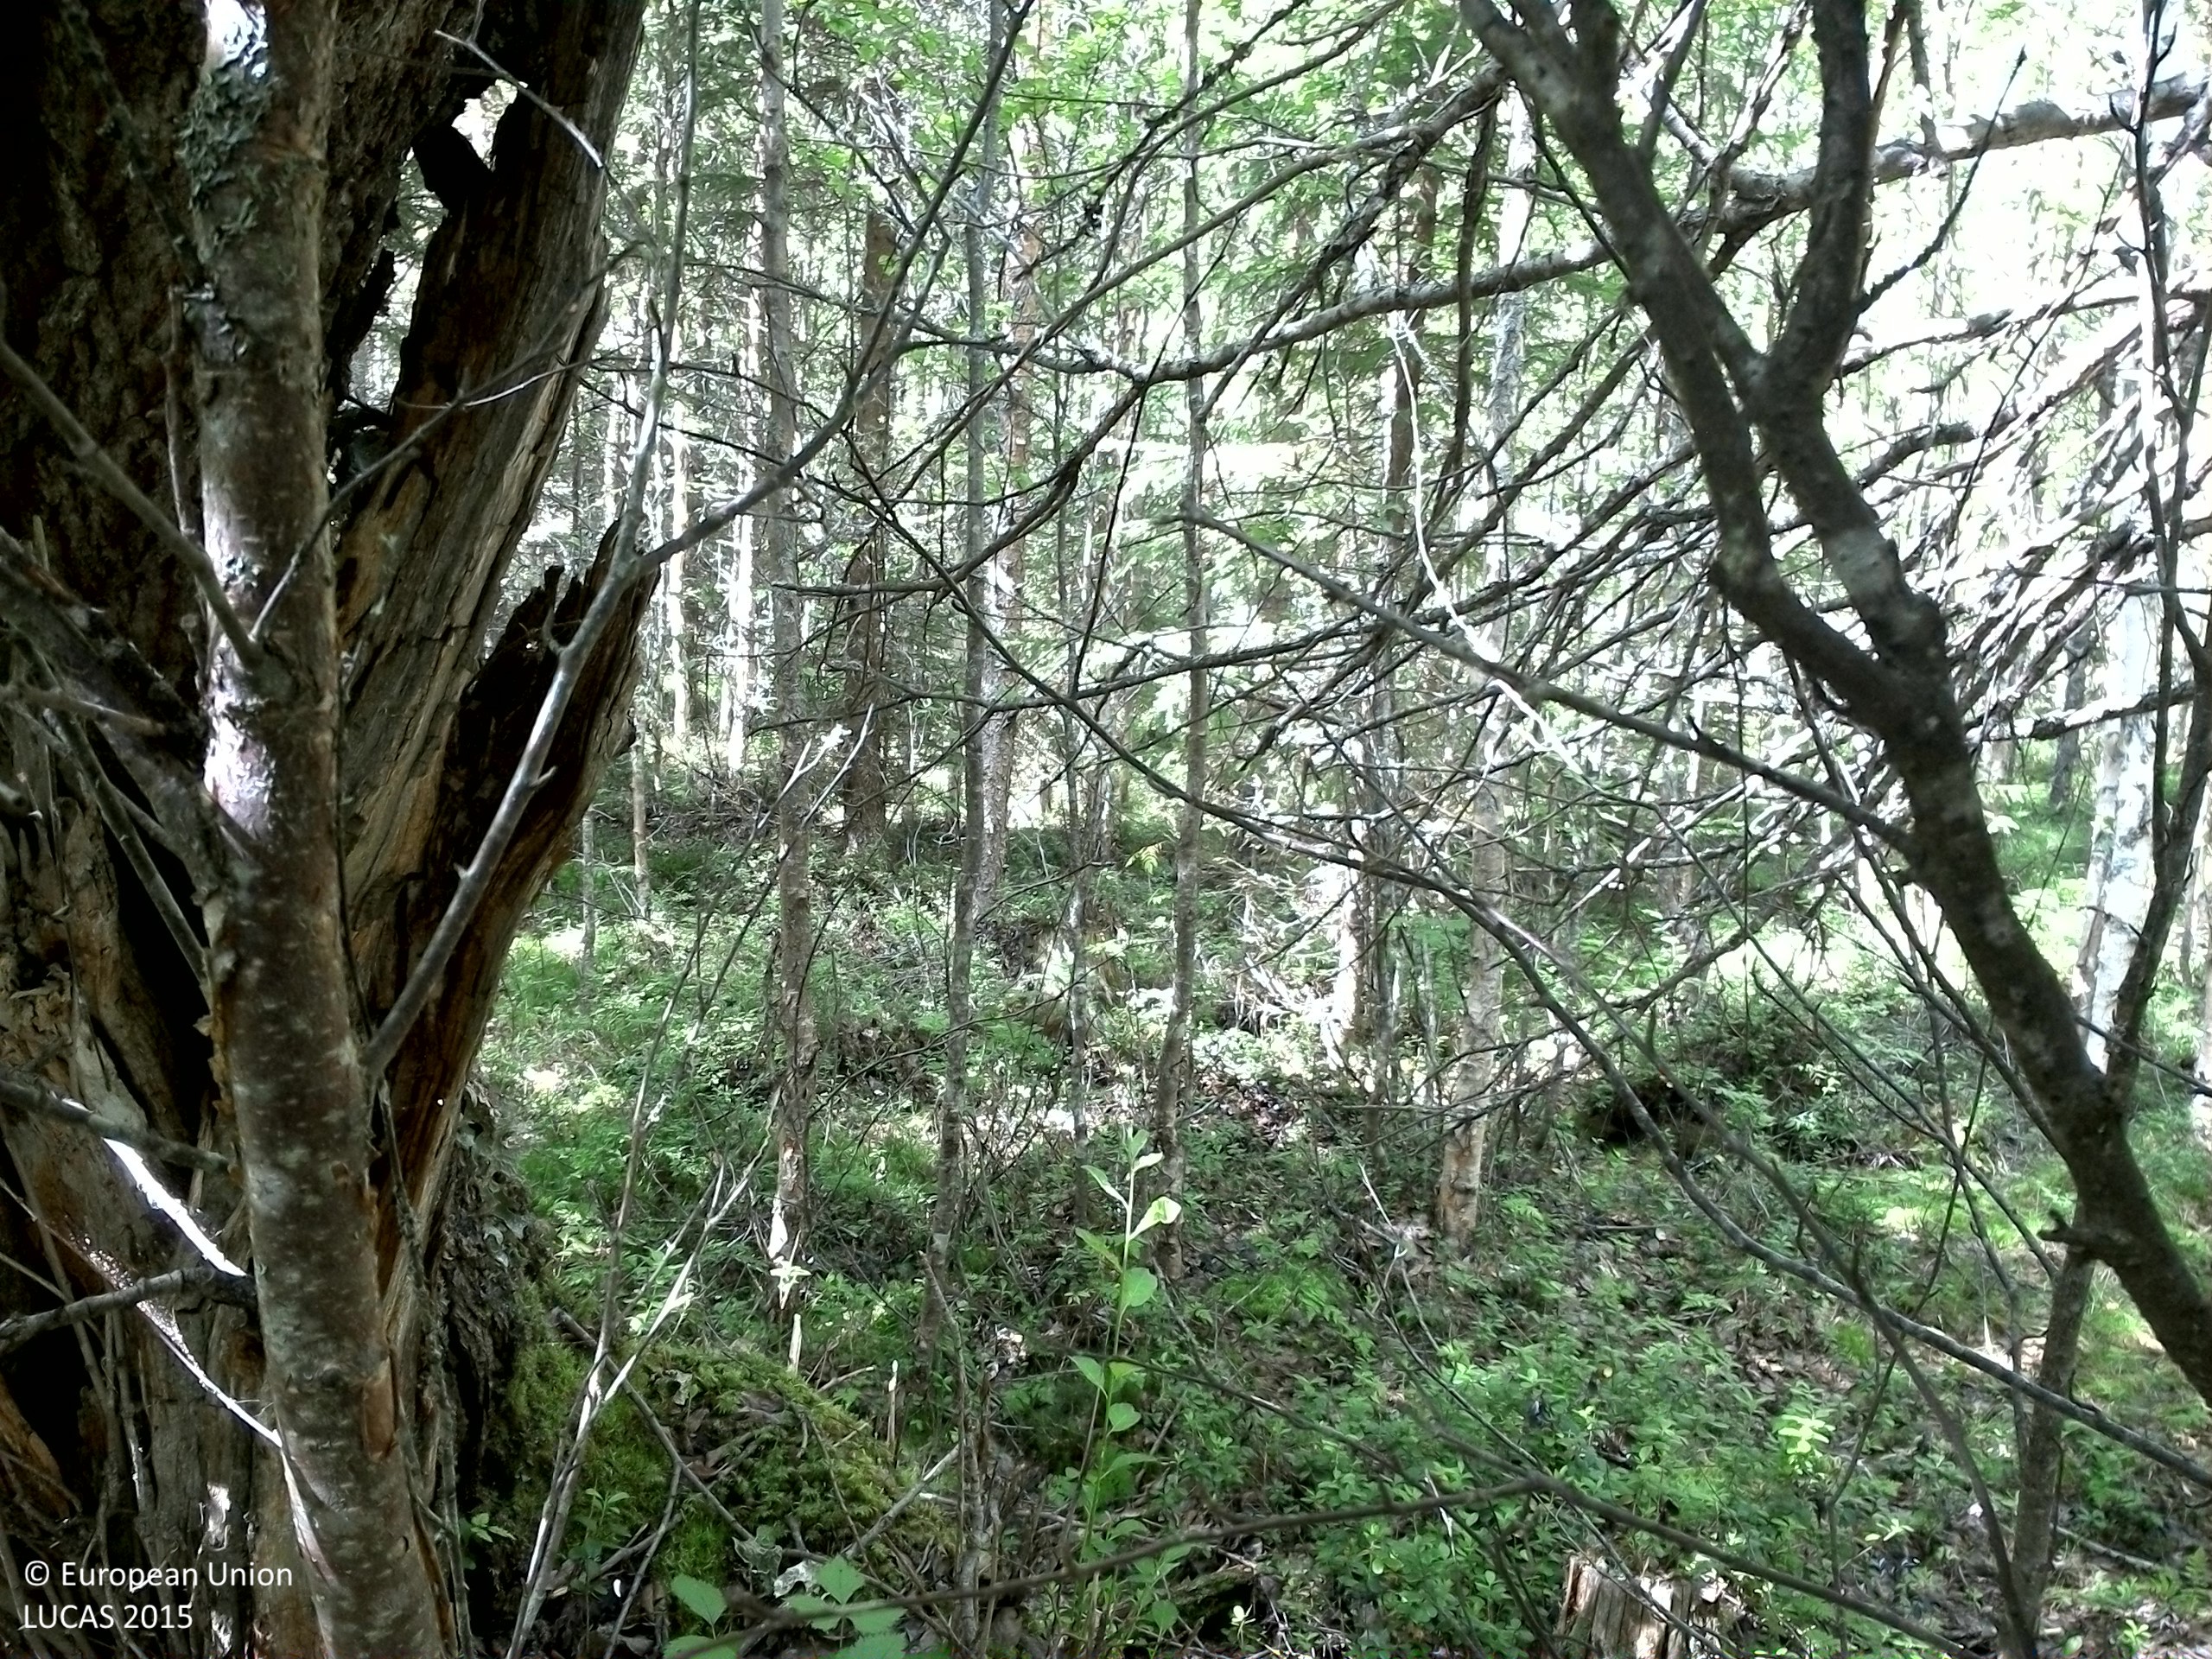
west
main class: Woodland
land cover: Spruce dominated mixed woodland
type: boreal forest
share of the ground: > 75 %
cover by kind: coniferous forest trees 45 %, broadleaved forest trees 35 %, shrubs 10 %, herbaceous plants 10 %
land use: Forestry
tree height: > 5 m
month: August
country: SE
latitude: 63.7568
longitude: 16.5195
